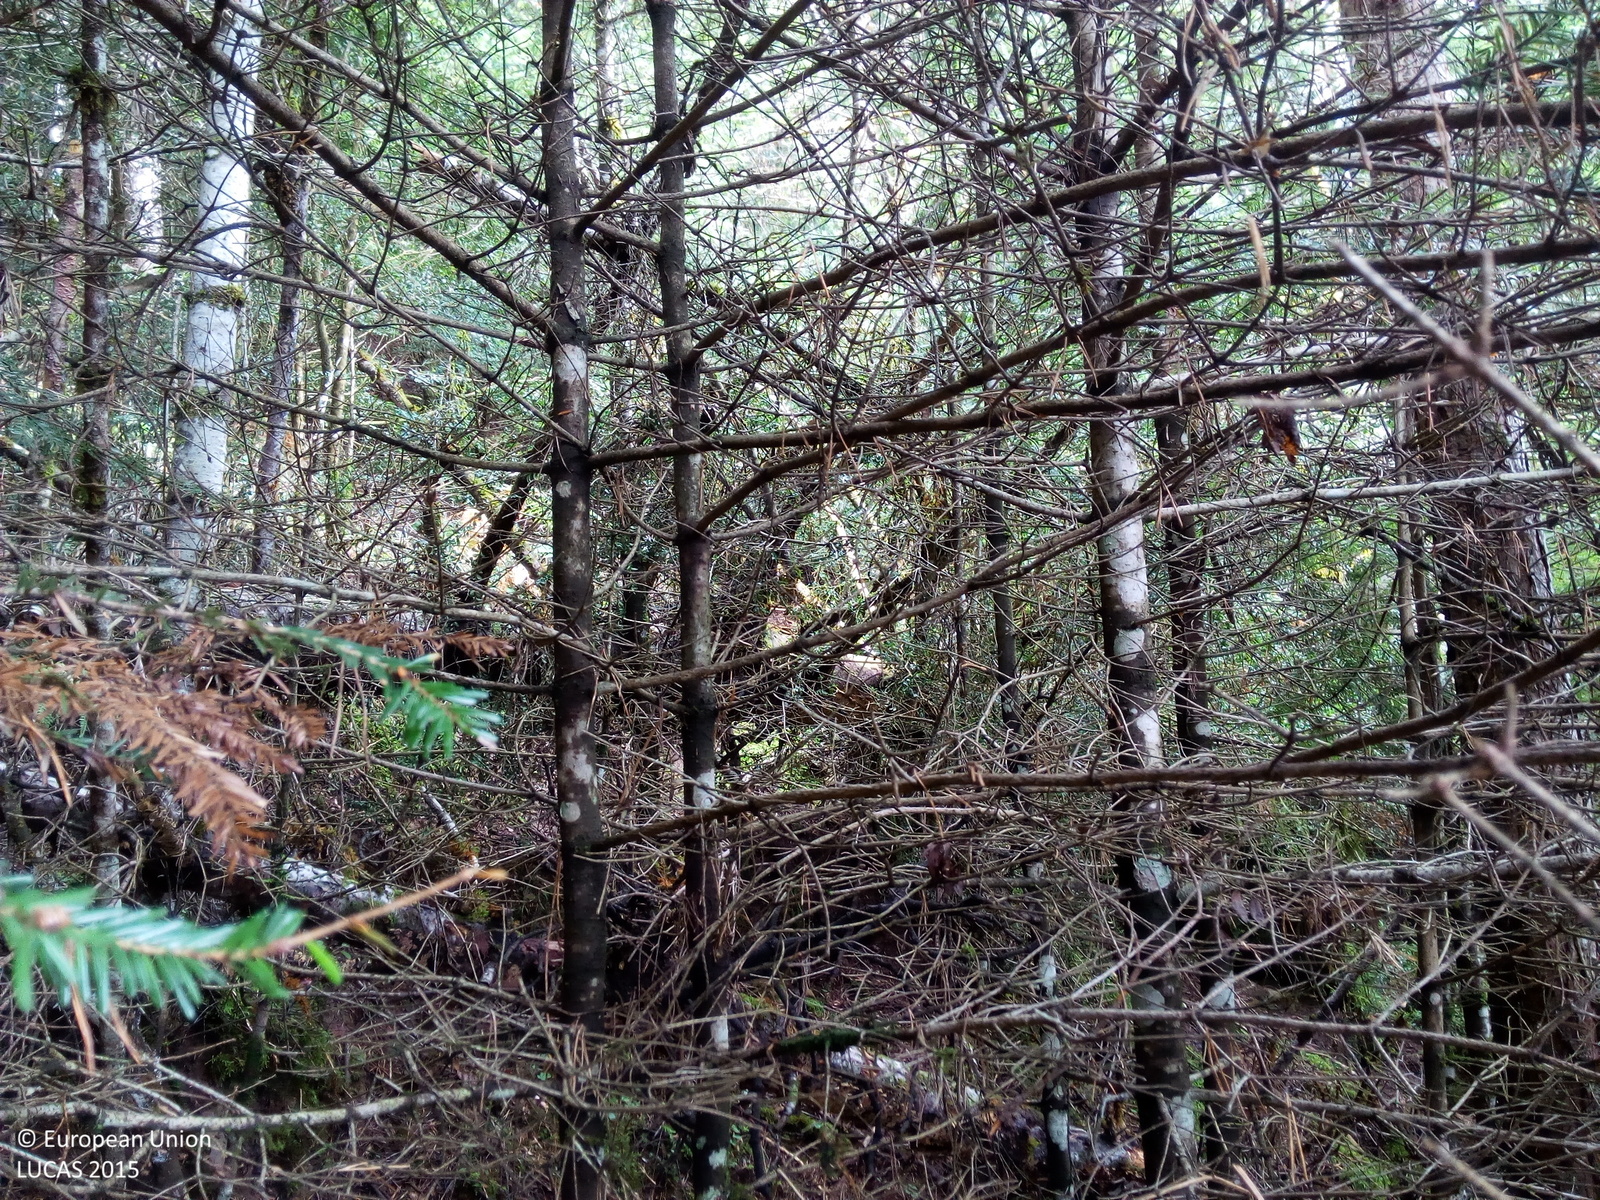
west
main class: Woodland
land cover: Spruce dominated coniferous woodland
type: alpine coniferous forest
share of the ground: > 75 %
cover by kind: coniferous forest trees 90 %, shrubs 10 %
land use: Semi-natural and natural areas not in use
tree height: > 5 m
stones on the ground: < 10 %
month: September
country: ES
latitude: 42.6308
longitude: 0.1857
